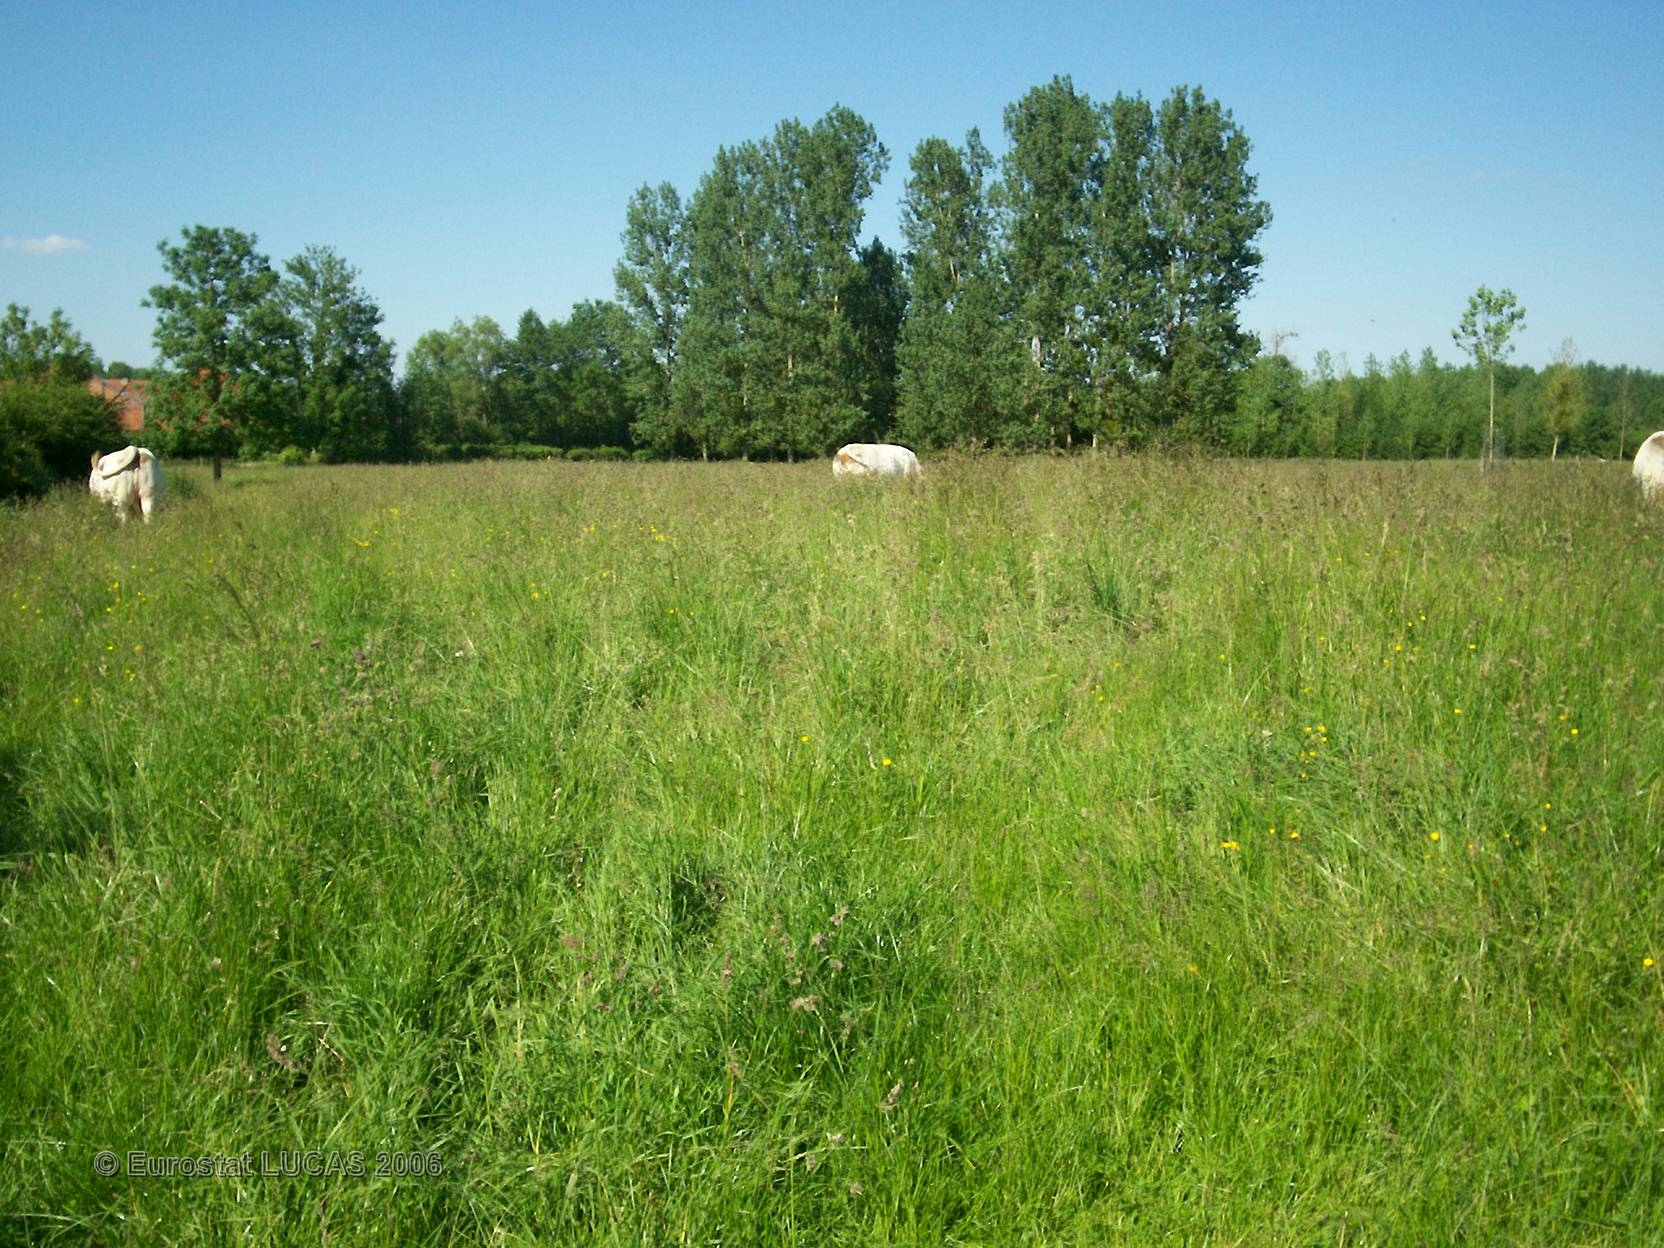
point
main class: Grassland
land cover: Grassland without tree/shrub cover
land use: Agriculture (excluding fallow land and kitchen gardens)
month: June
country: FR
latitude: 48.7416
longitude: 4.6258
